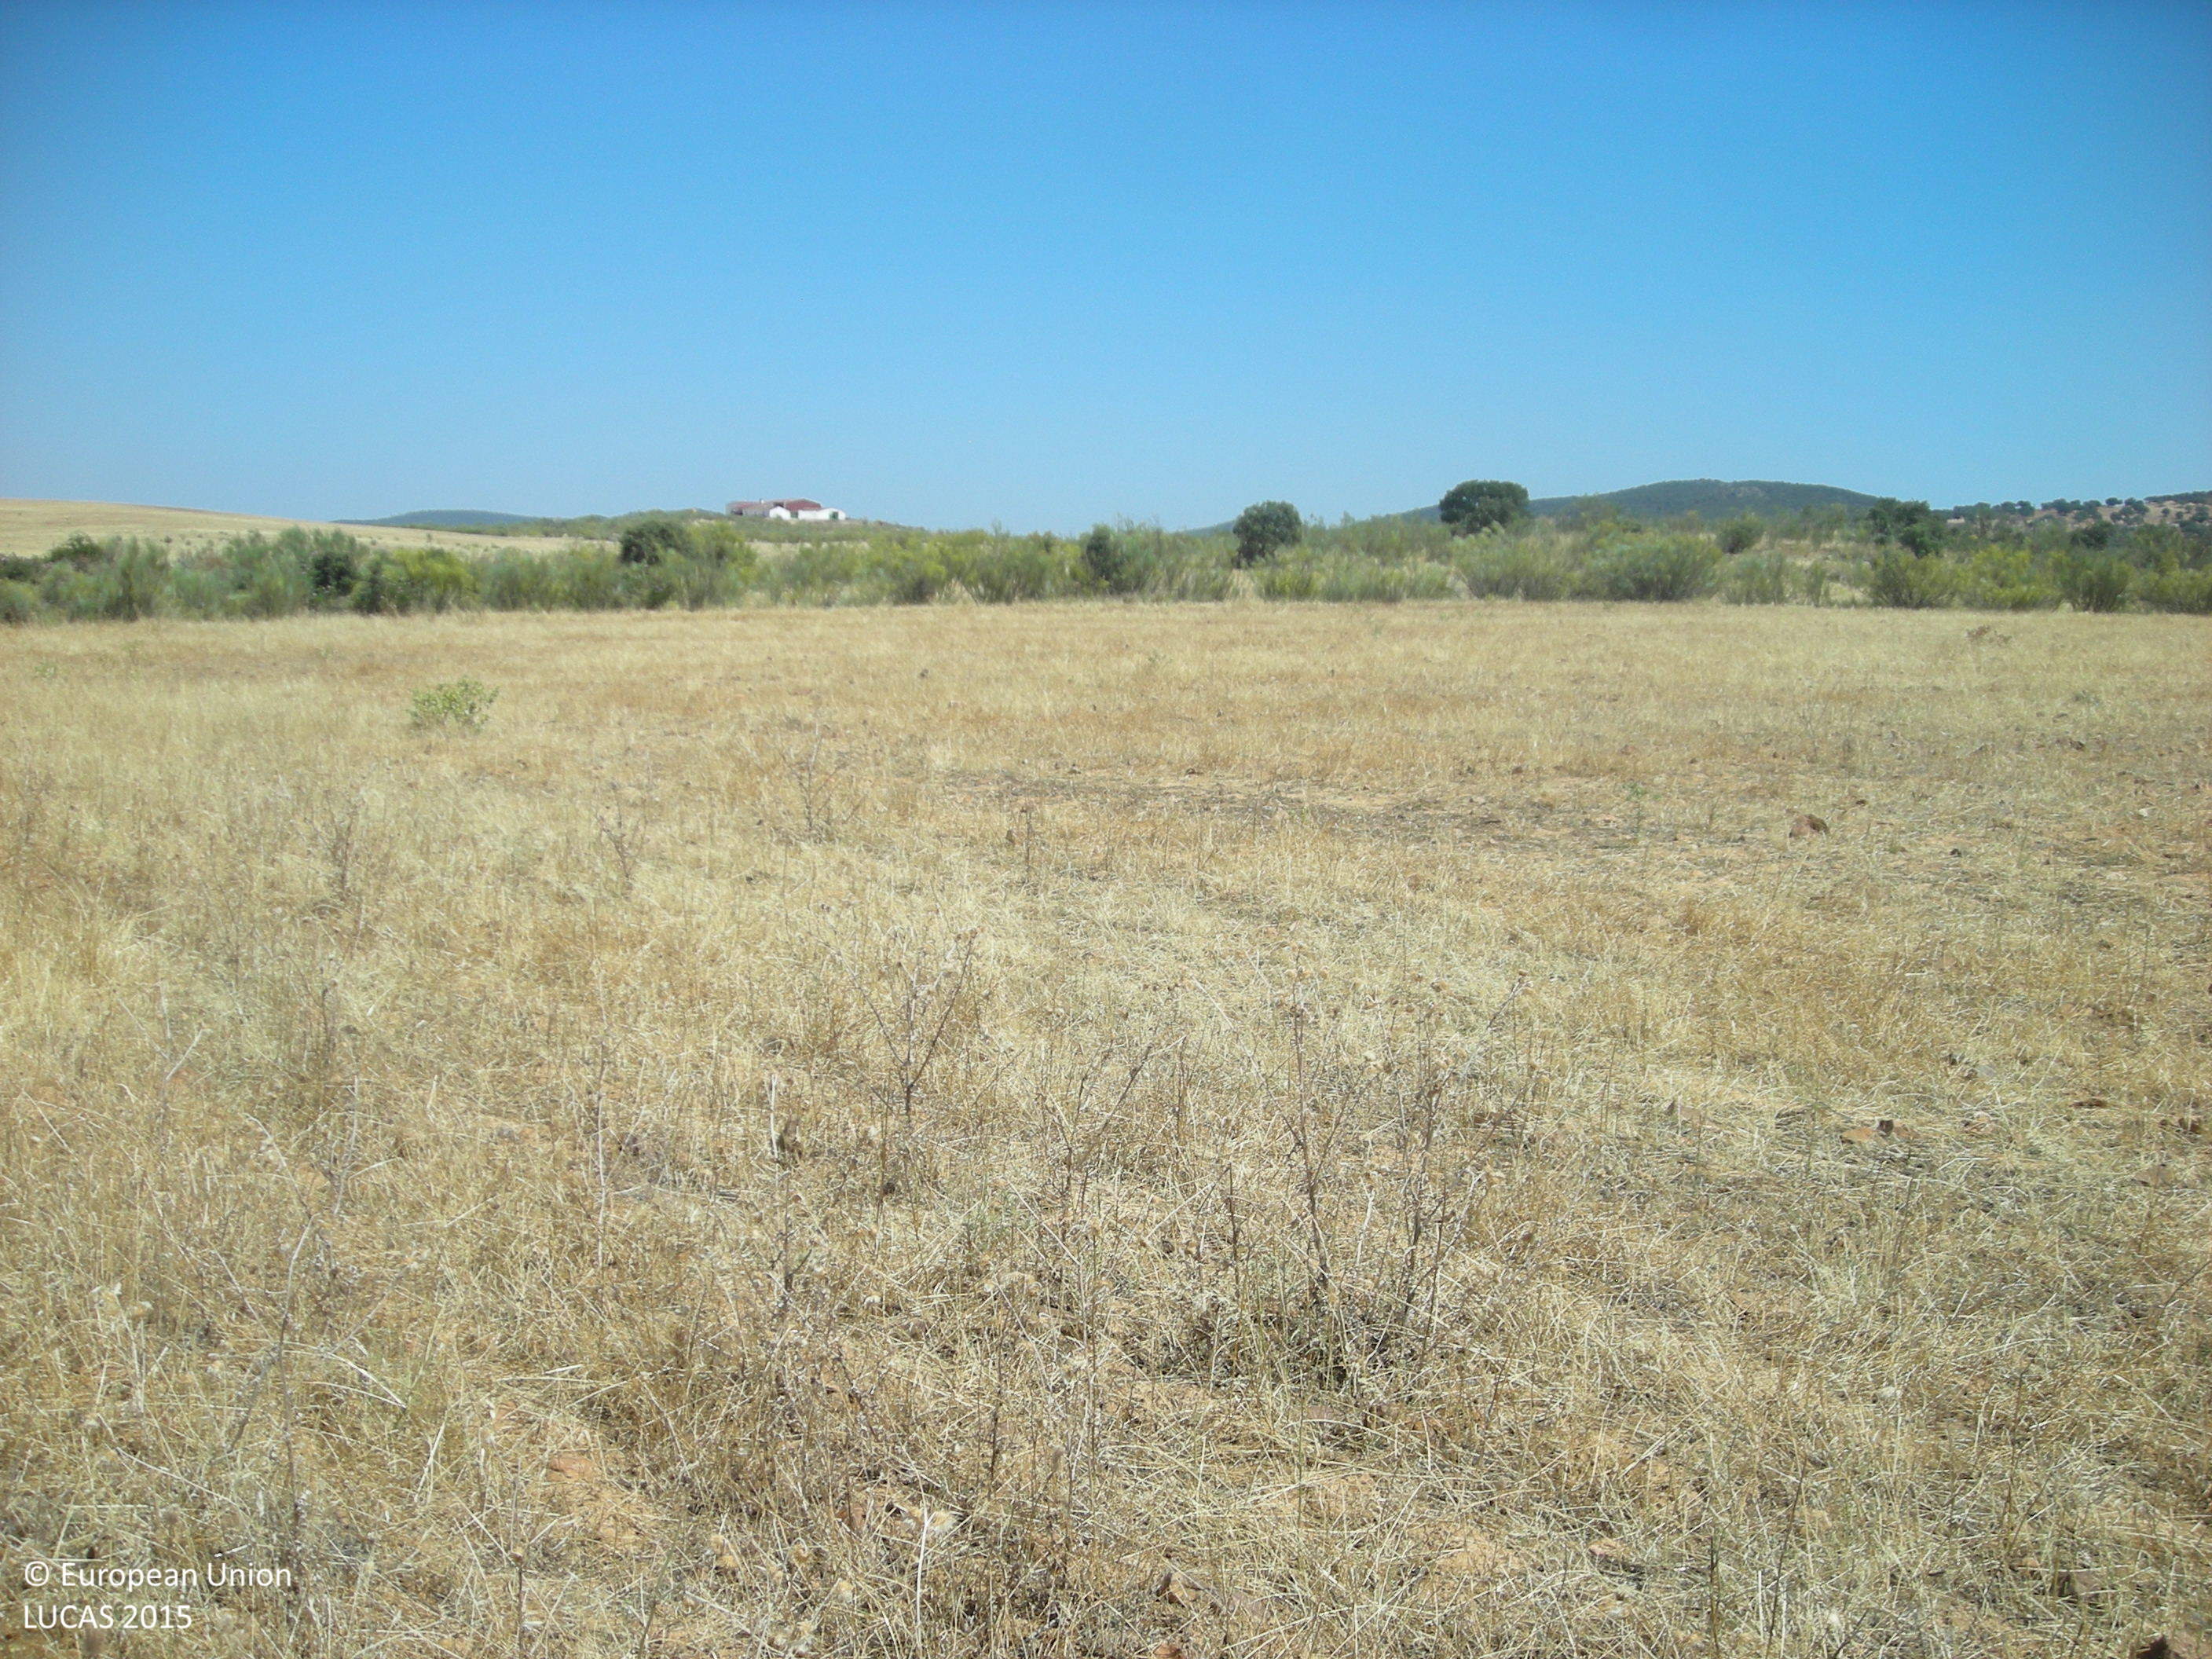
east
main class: Woodland
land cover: Broadleaved woodland
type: broadleaved evergreen forest
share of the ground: 25 - 50 %
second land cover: Grassland without tree/shrub cover
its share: 50 - 75 %
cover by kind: herbaceous plants 60 %, broadleaved forest trees 40 %
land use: Forestry
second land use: Agriculture (excluding fallow land and kitchen gardens)
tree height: > 5 m
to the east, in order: Broadleaved woodland; Grassland without tree/shrub cover; Shrubland with sparse tree cover; Broadleaved woodland
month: June
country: ES
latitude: 38.6297
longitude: -5.7913
